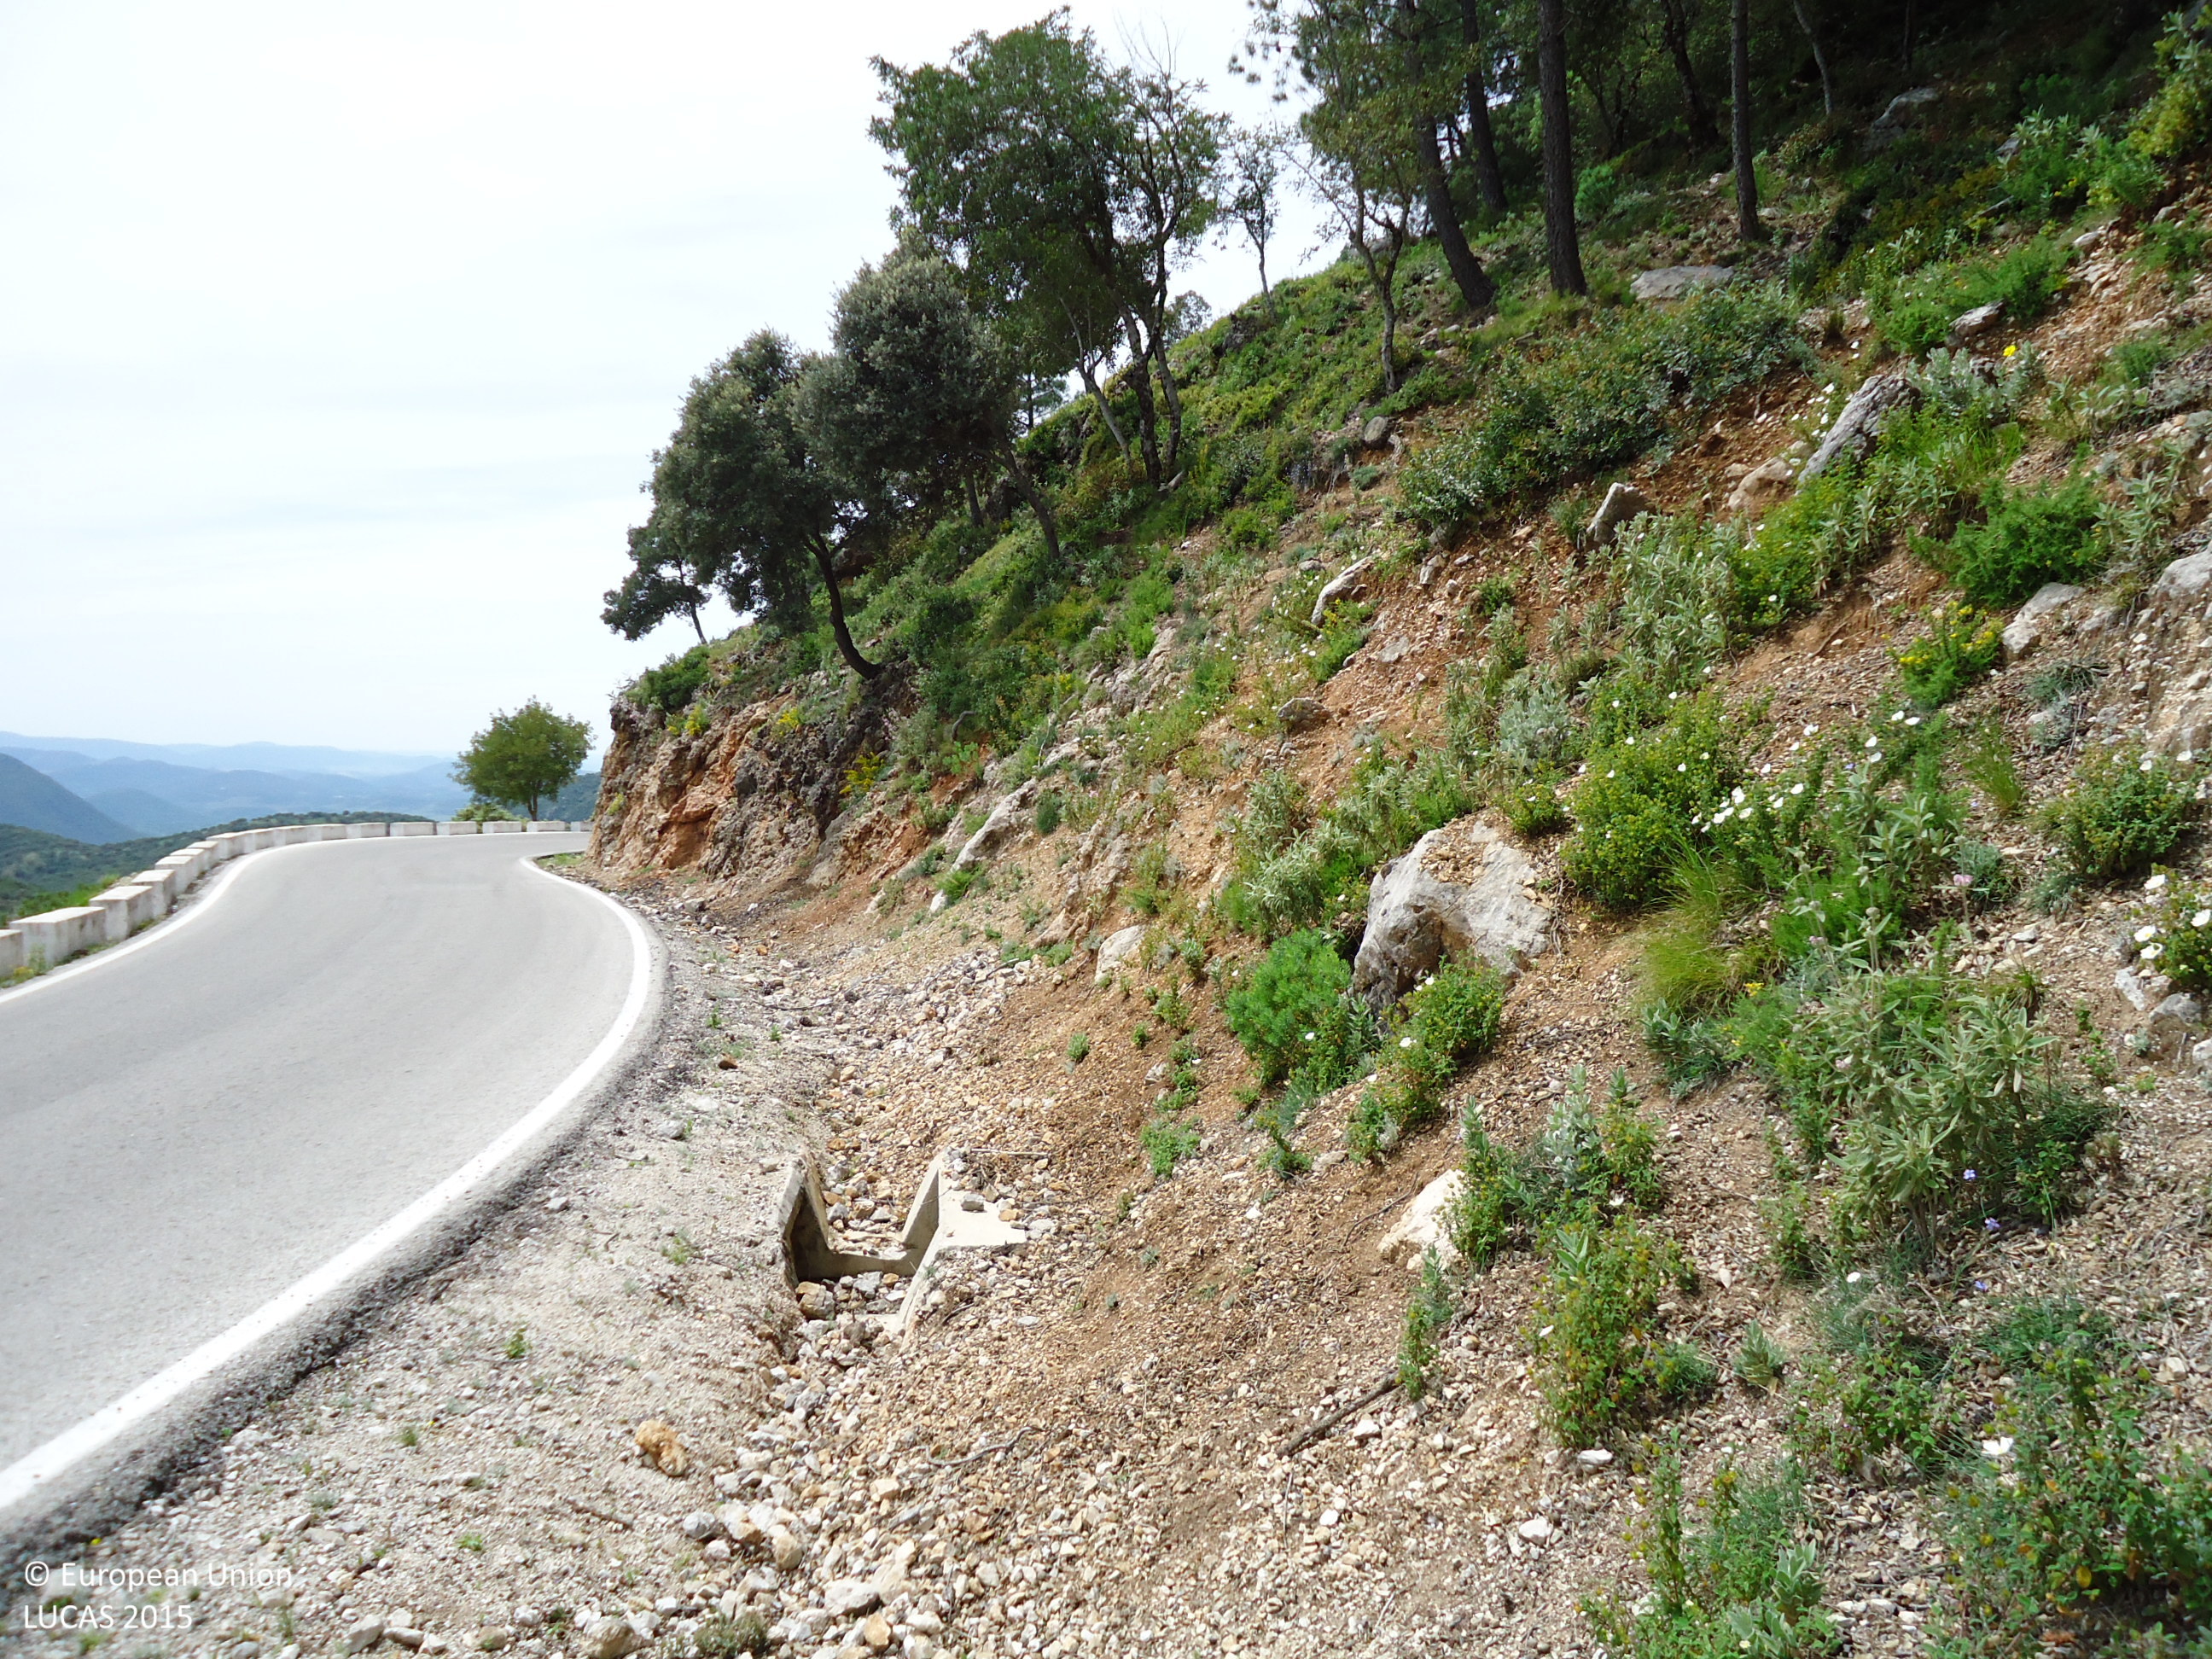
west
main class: Woodland
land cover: Broadleaved woodland
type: broadleaved evergreen forest
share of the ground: > 75 %
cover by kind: broadleaved forest trees 80 %, shrubs 10 %, coniferous forest trees 5 %, herbaceous plants 5 %
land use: Semi-natural and natural areas not in use
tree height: > 5 m
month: May
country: ES
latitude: 36.7567
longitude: -5.4274
